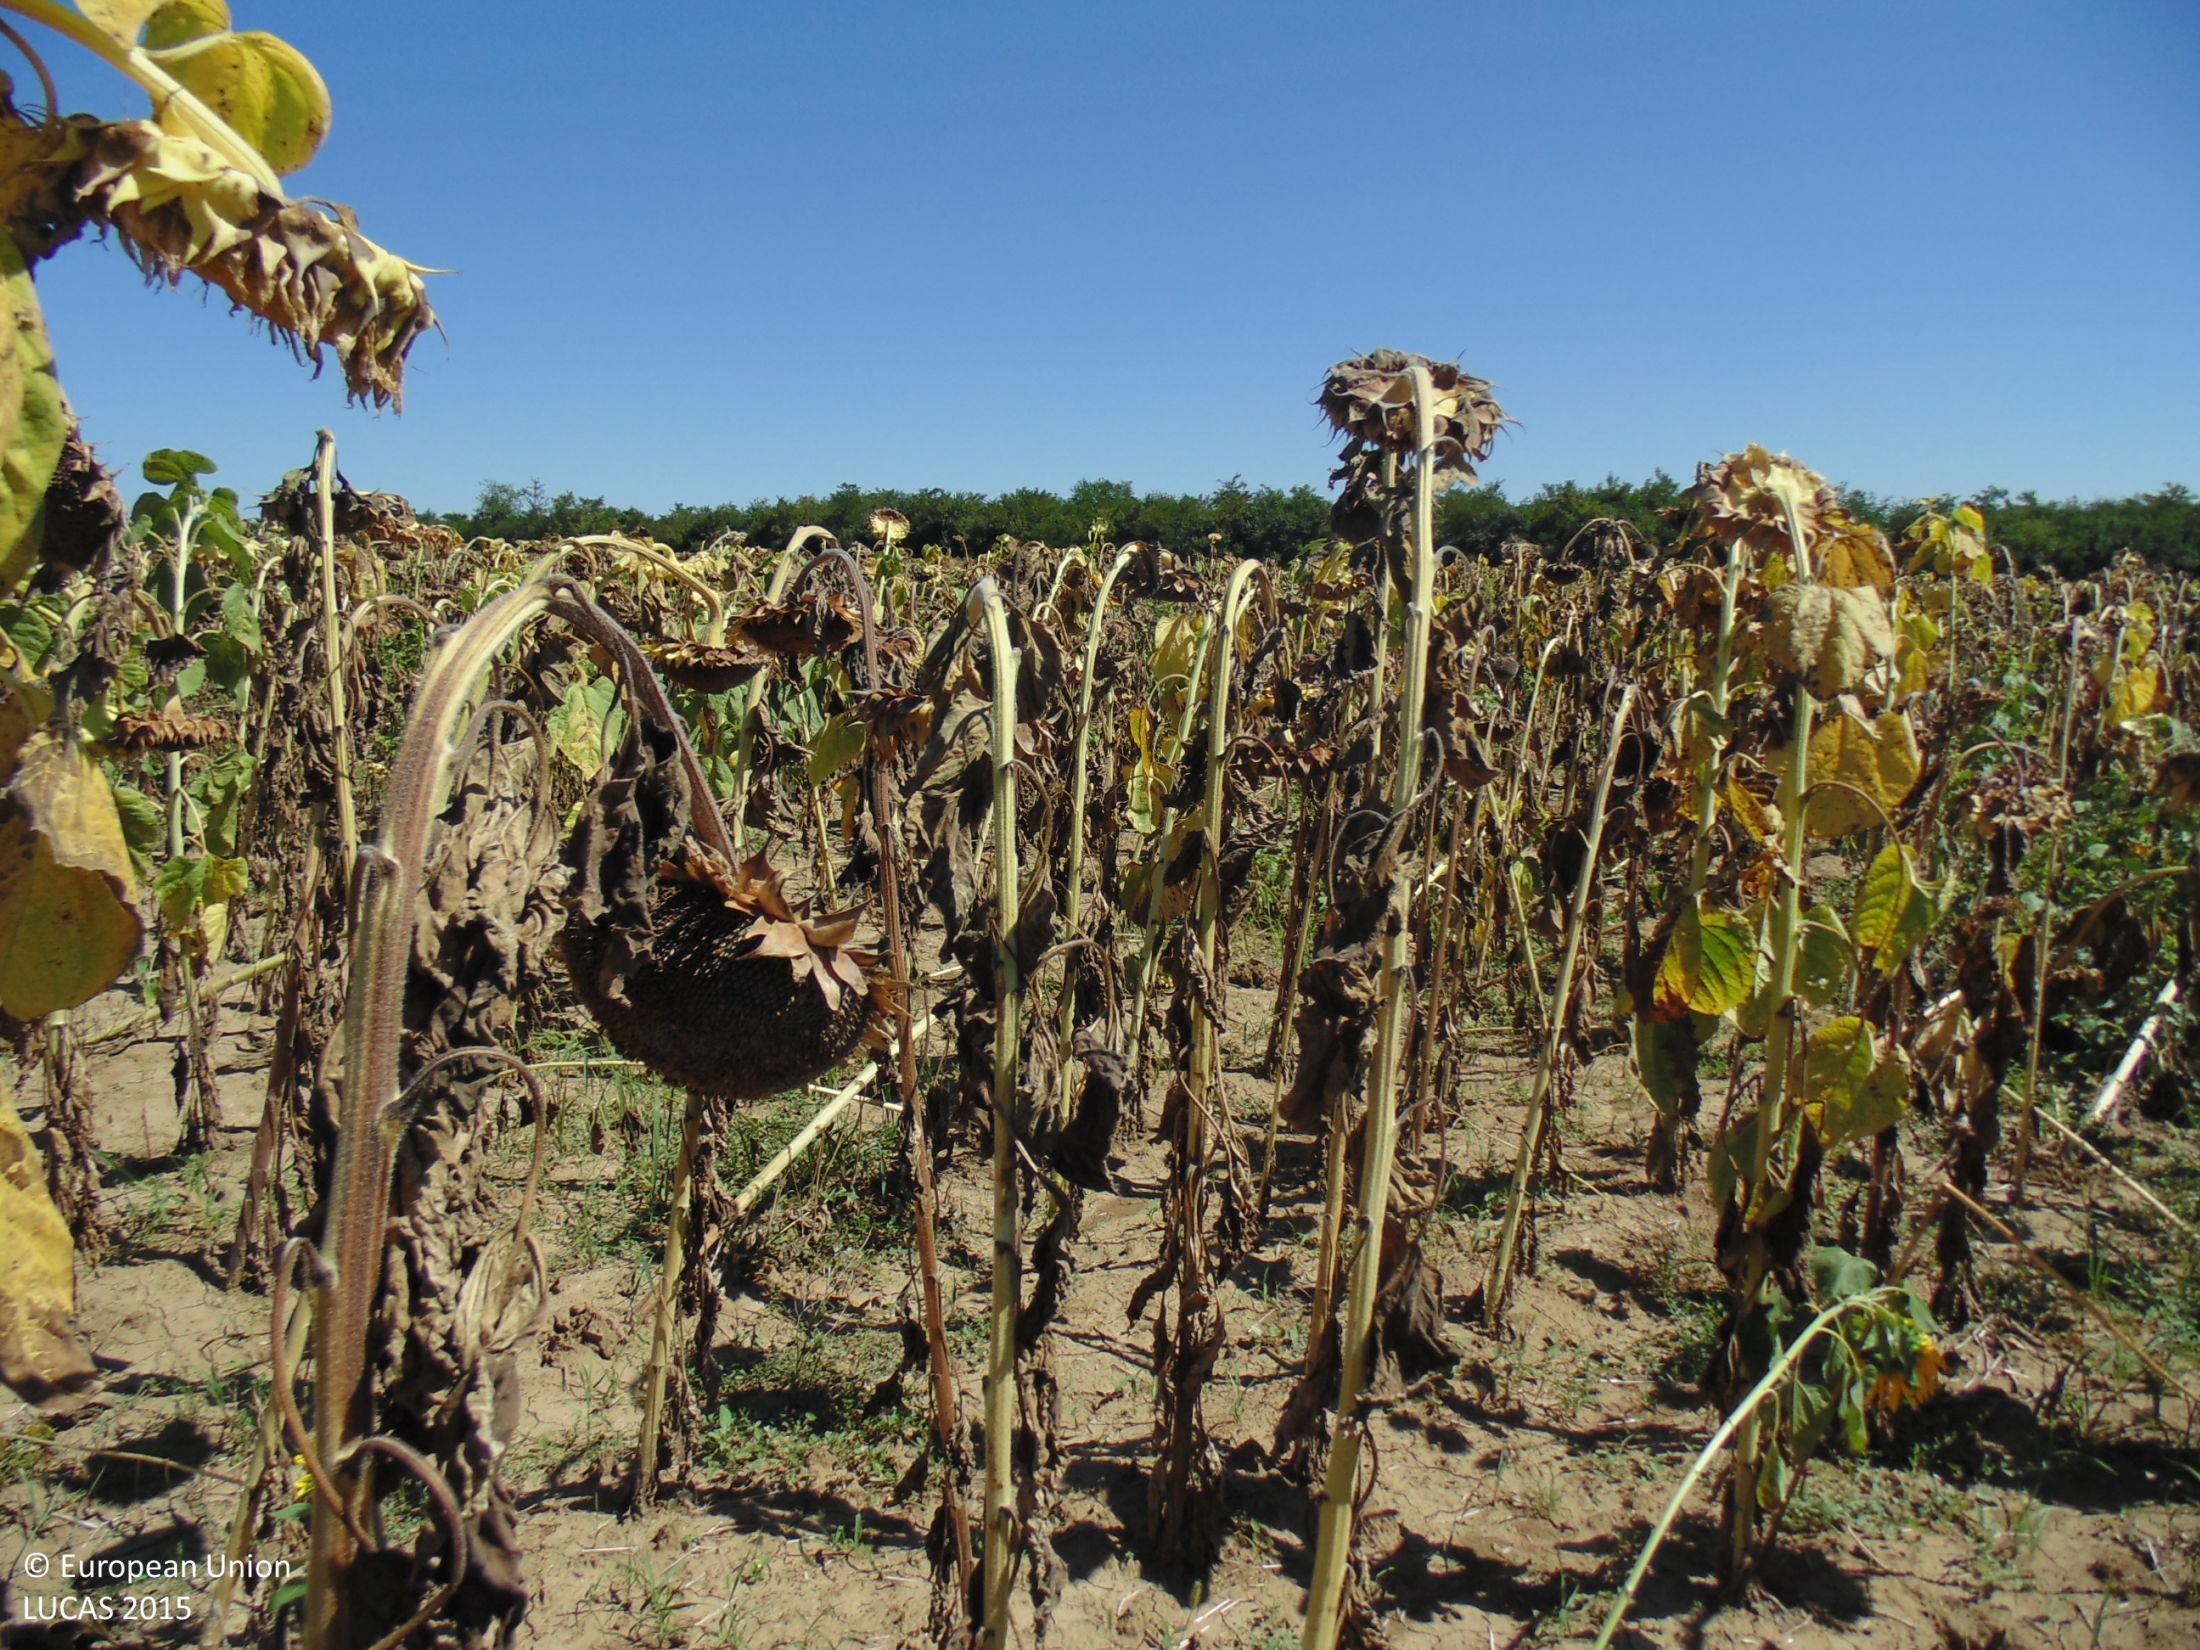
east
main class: Cropland
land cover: Sunflower
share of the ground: > 75 %
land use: Agriculture (excluding fallow land and kitchen gardens)
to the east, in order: Sunflower; Grass margins; Soya; Sunflower; Grass margins; Tracks; Grass margins; Broadleaved woodland; Grass margins; Common wheat
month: September
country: BG
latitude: 43.7643
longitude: 27.1039
